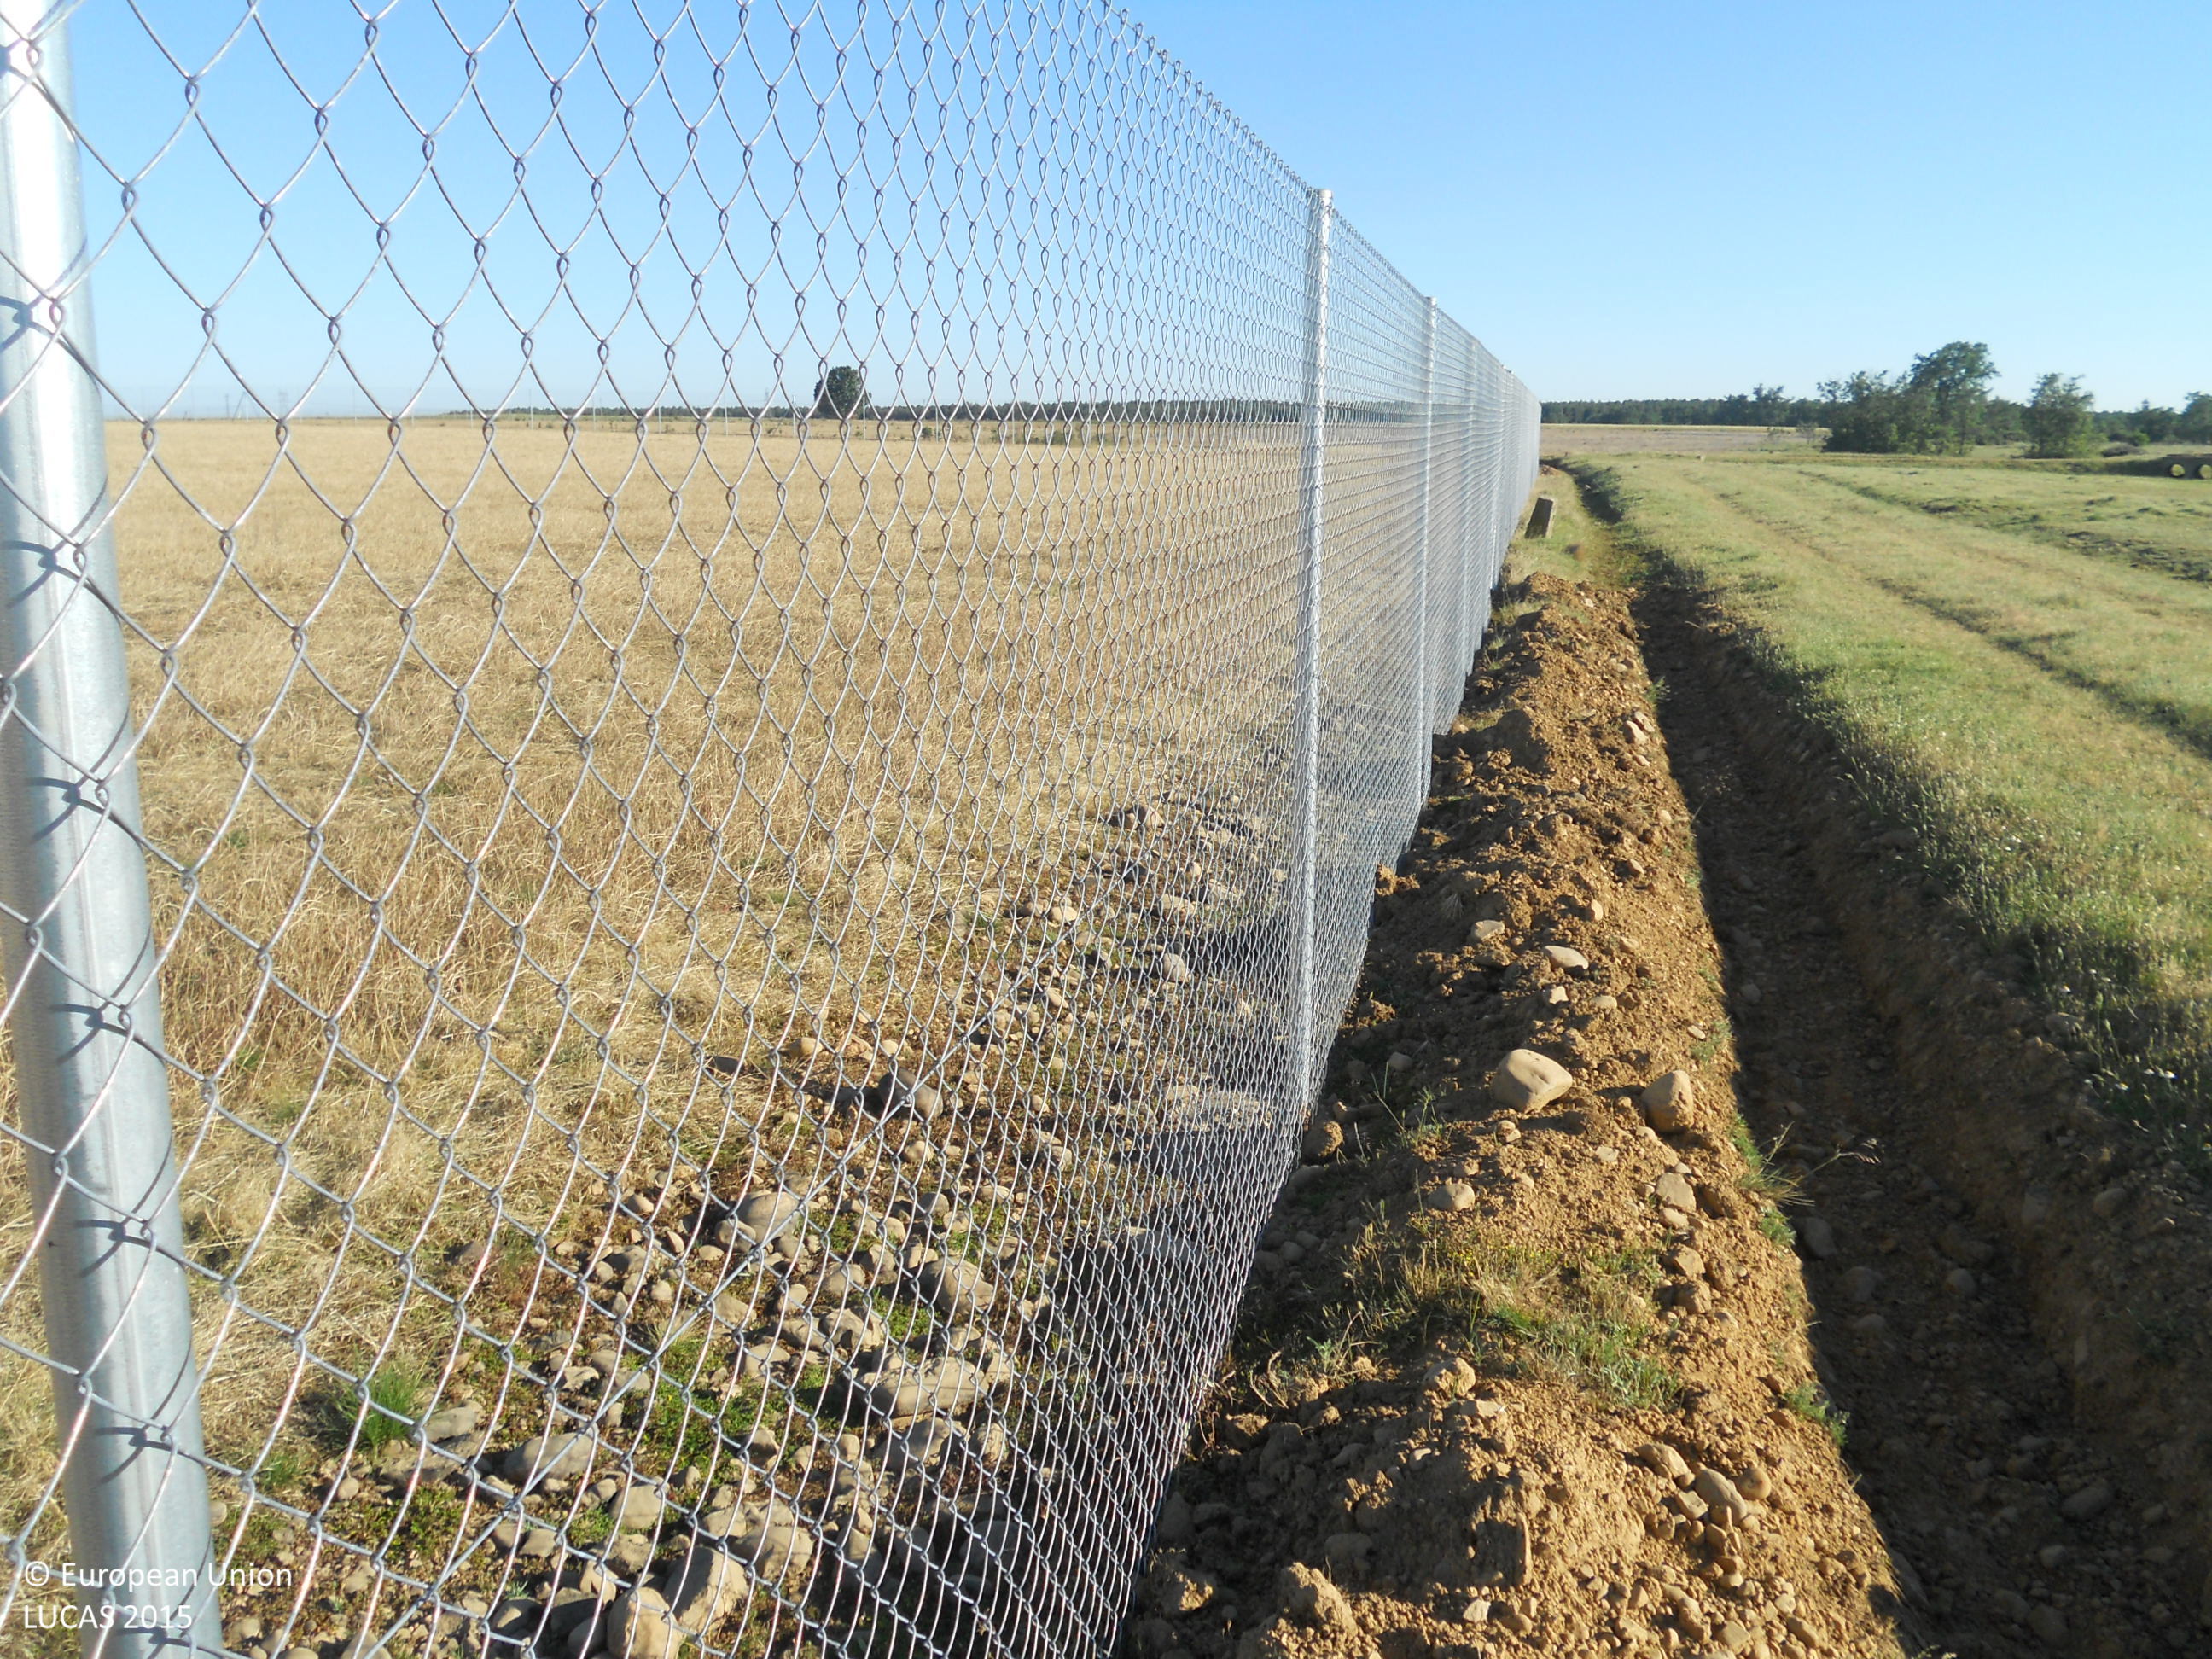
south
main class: Grassland
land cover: Spontaneously vegetated surfaces
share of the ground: > 75 %
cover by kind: herbaceous plants 100 %
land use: Fallow land
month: June
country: ES
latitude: 42.5594
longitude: -4.8570
